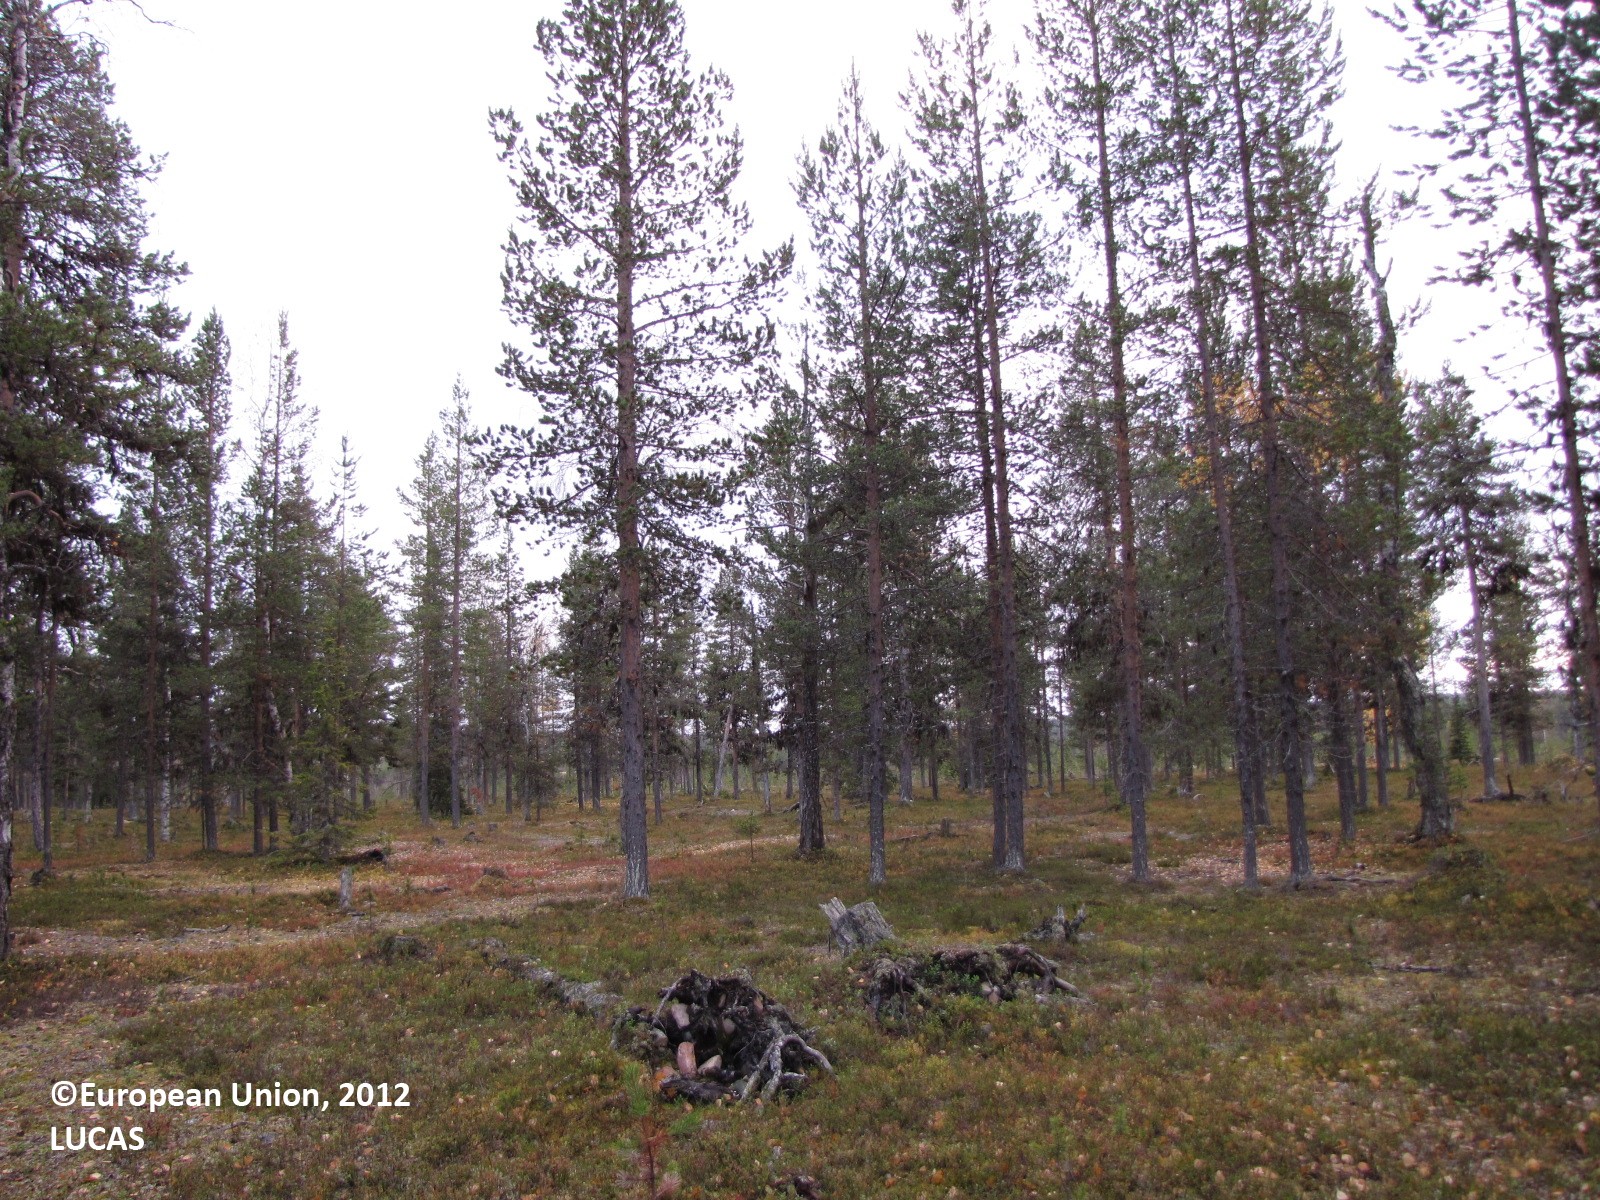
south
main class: Woodland
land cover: Pine dominated mixed woodland
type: boreal forest
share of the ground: 25 - 50 %
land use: Forestry
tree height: > 5 m
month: September
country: FI
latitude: 67.9250
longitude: 24.4490
